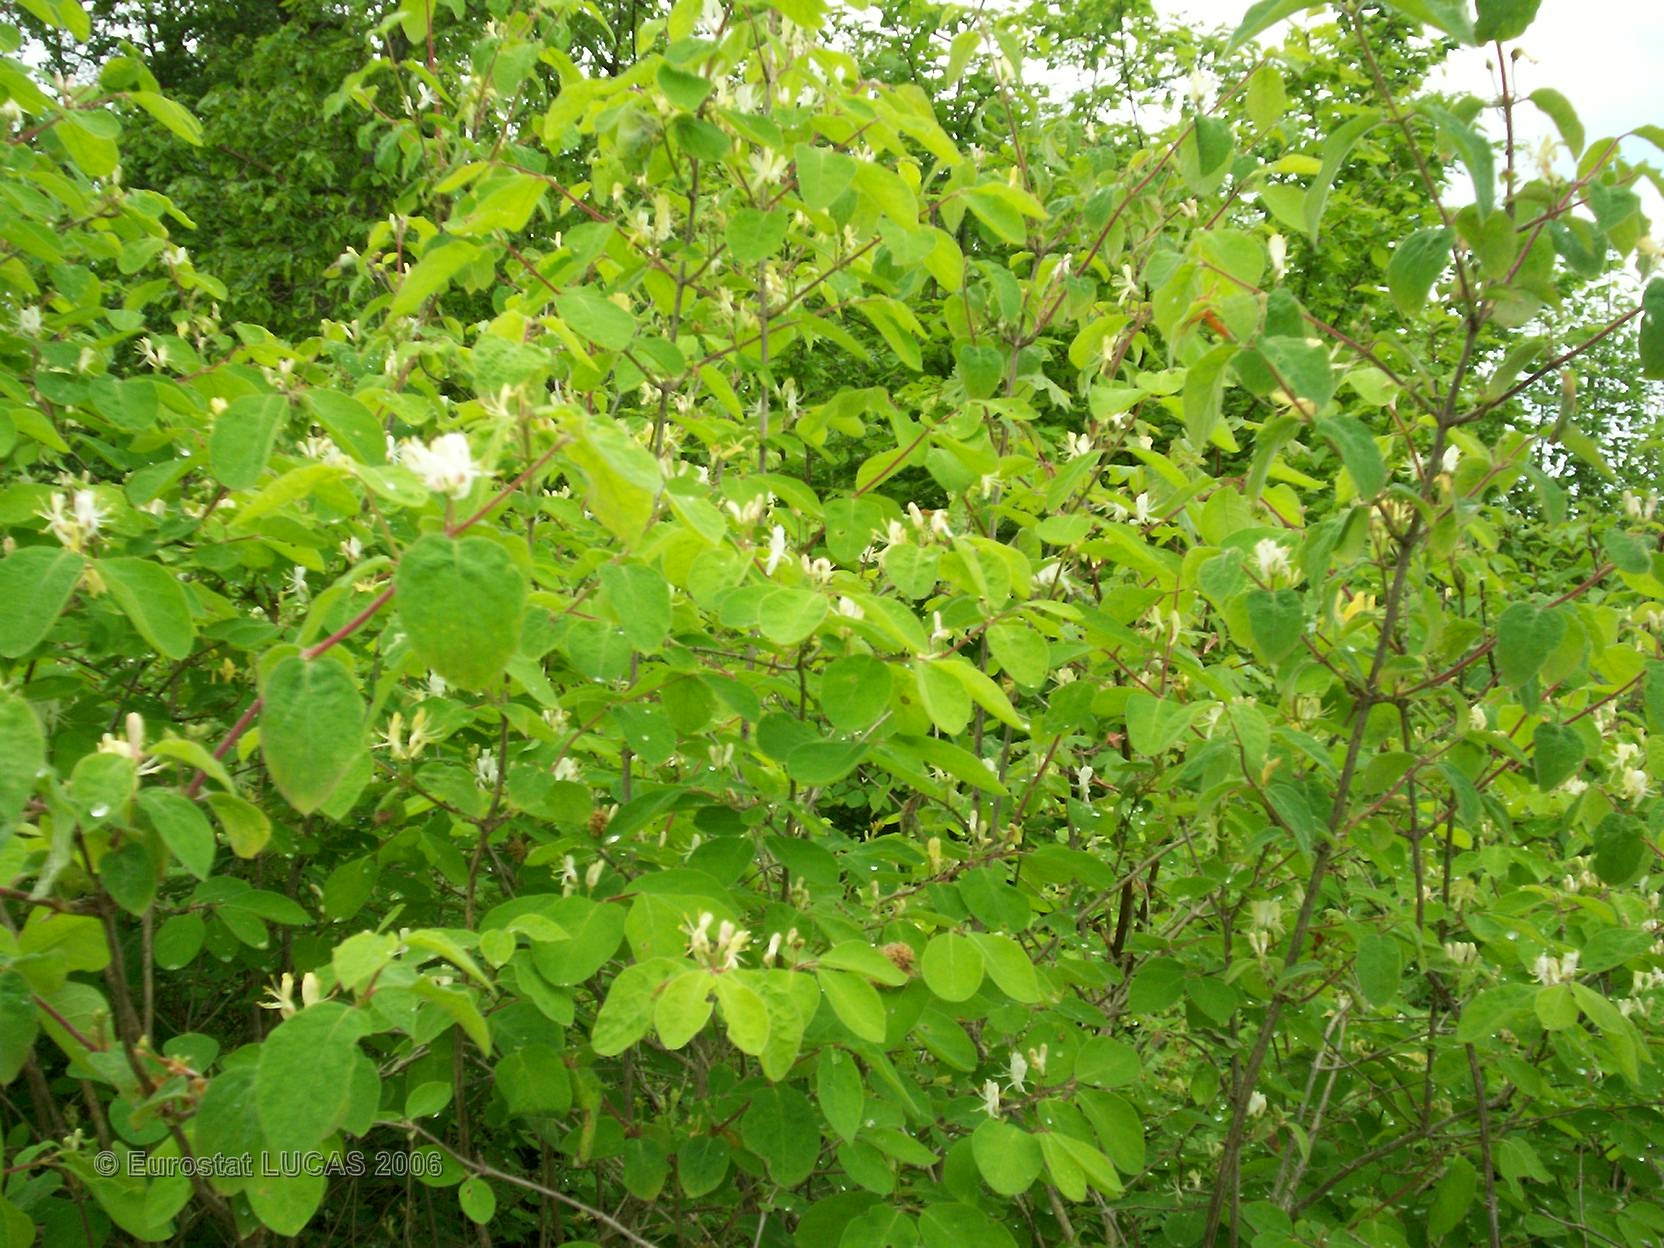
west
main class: Woodland
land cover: Broadleaved forest
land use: Forestry
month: May
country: FR
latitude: 48.5445
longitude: 5.9226
